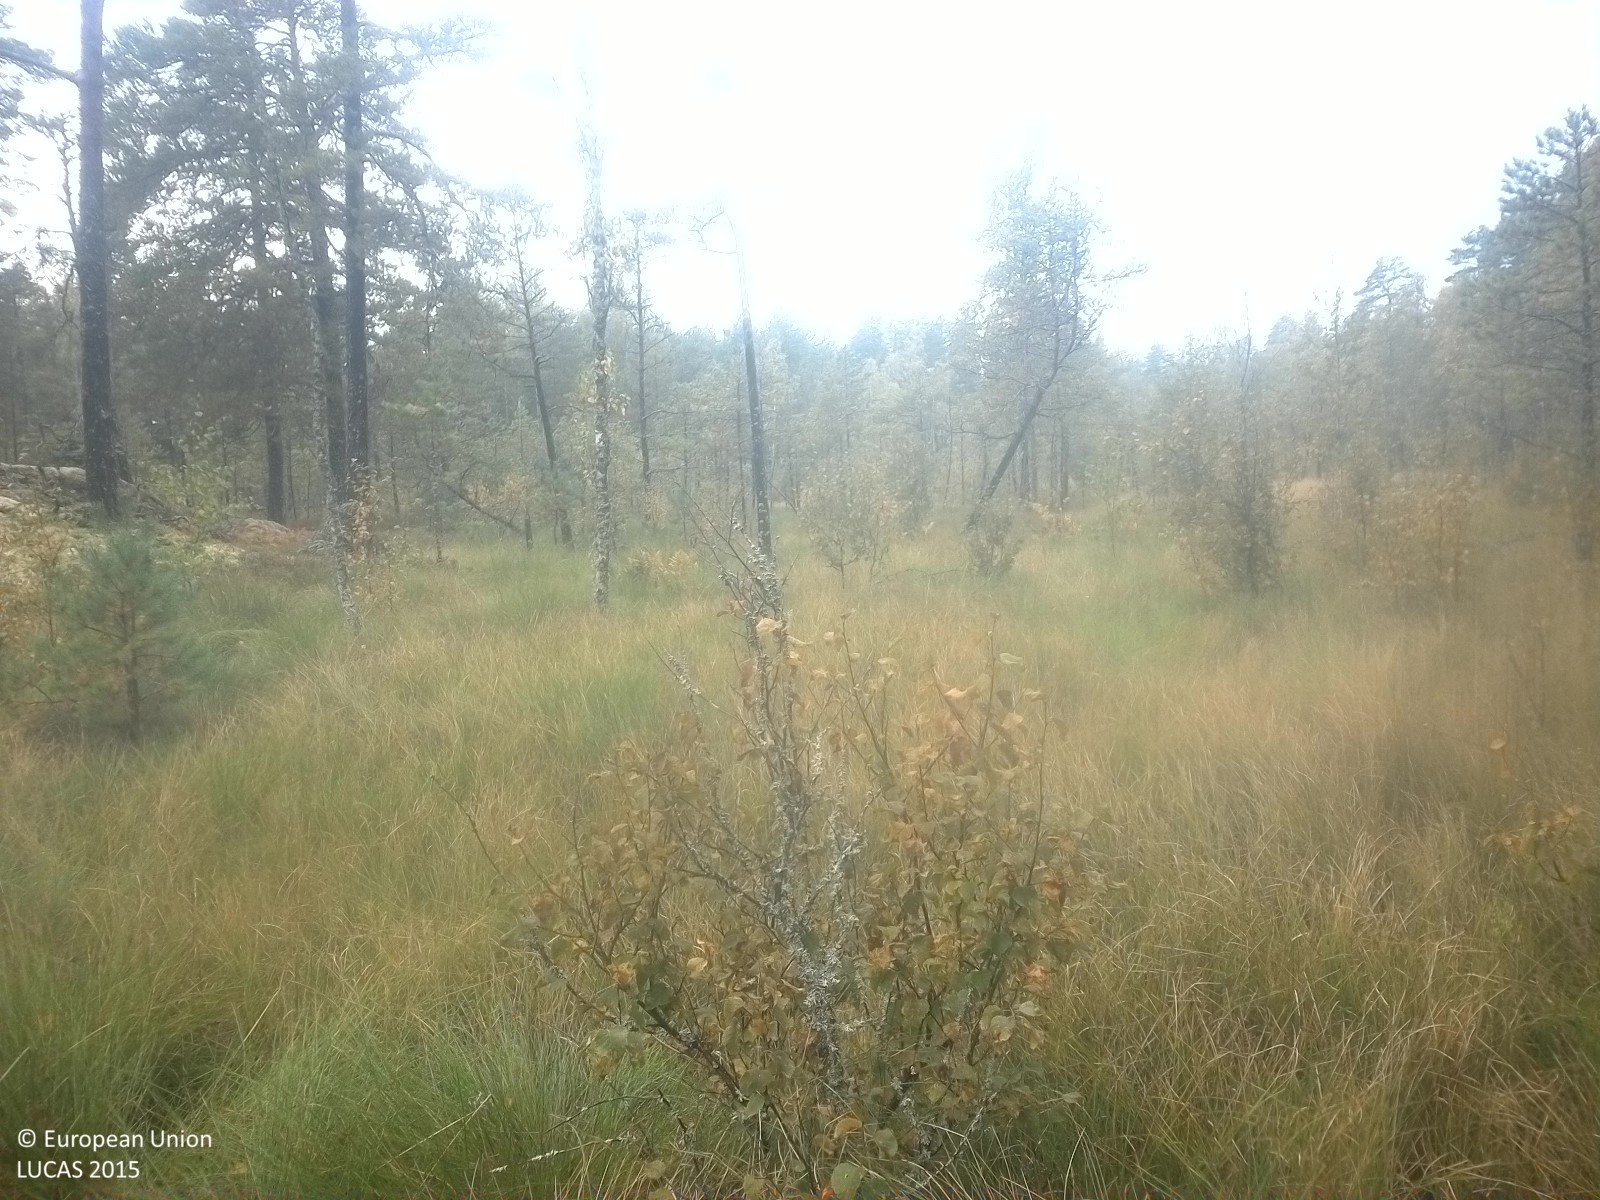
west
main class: Woodland
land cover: Broadleaved woodland
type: hemiboreal forest and nemoral coniferous forest and mixed broadleaved-coniferous forest
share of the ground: 10 - 25 %
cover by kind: herbaceous plants 70 %, broadleaved forest trees 15 %, lichens and mosses 10 %, coniferous forest trees 5 %
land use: Semi-natural and natural areas not in use
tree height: < 5 m
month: September
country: SE
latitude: 58.5001
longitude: 16.7748
